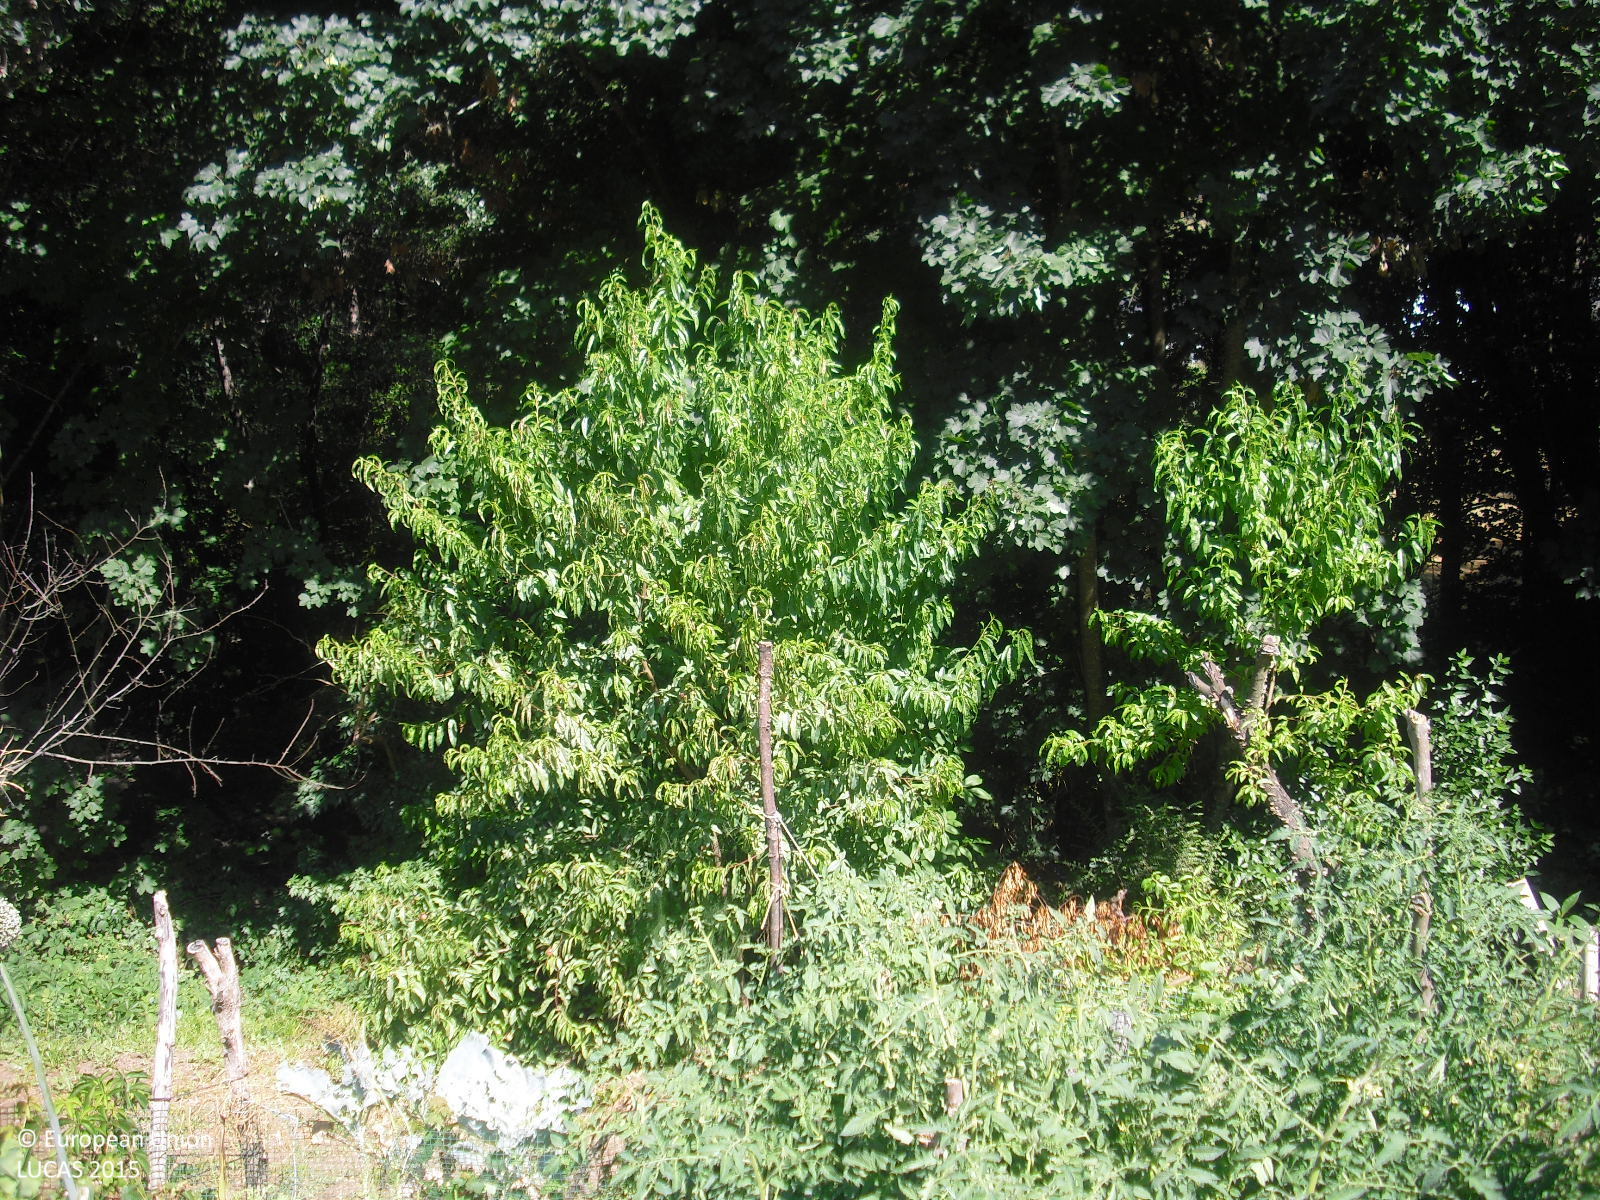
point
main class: Cropland
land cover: Other fruit trees and berries
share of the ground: 50 - 75 %
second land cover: Spontaneously vegetated surfaces
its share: 50 - 75 %
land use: Agriculture (excluding fallow land and kitchen gardens)
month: July
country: ES
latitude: 42.4909
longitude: -7.2291
